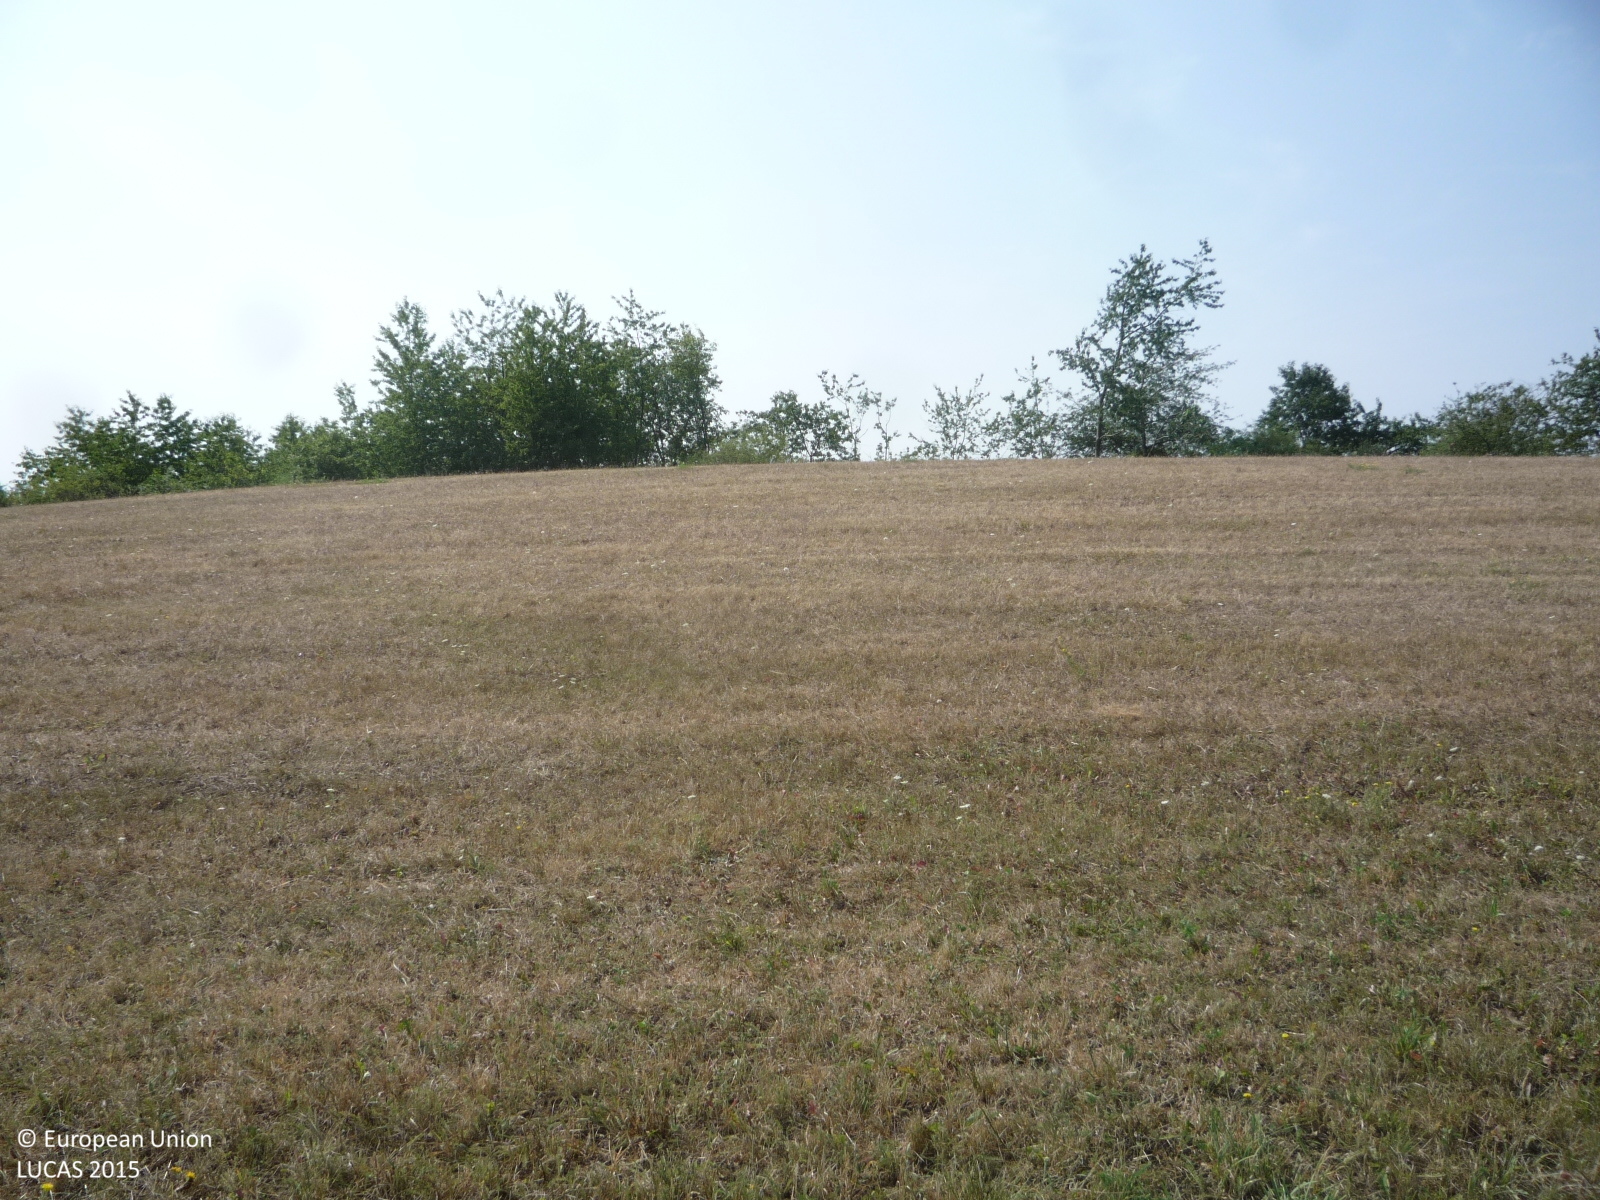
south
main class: Grassland
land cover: Grassland without tree/shrub cover
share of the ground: > 75 %
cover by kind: herbaceous plants 100 %
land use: Agriculture (excluding fallow land and kitchen gardens)
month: August
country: CZ
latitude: 49.8739
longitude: 14.6355
